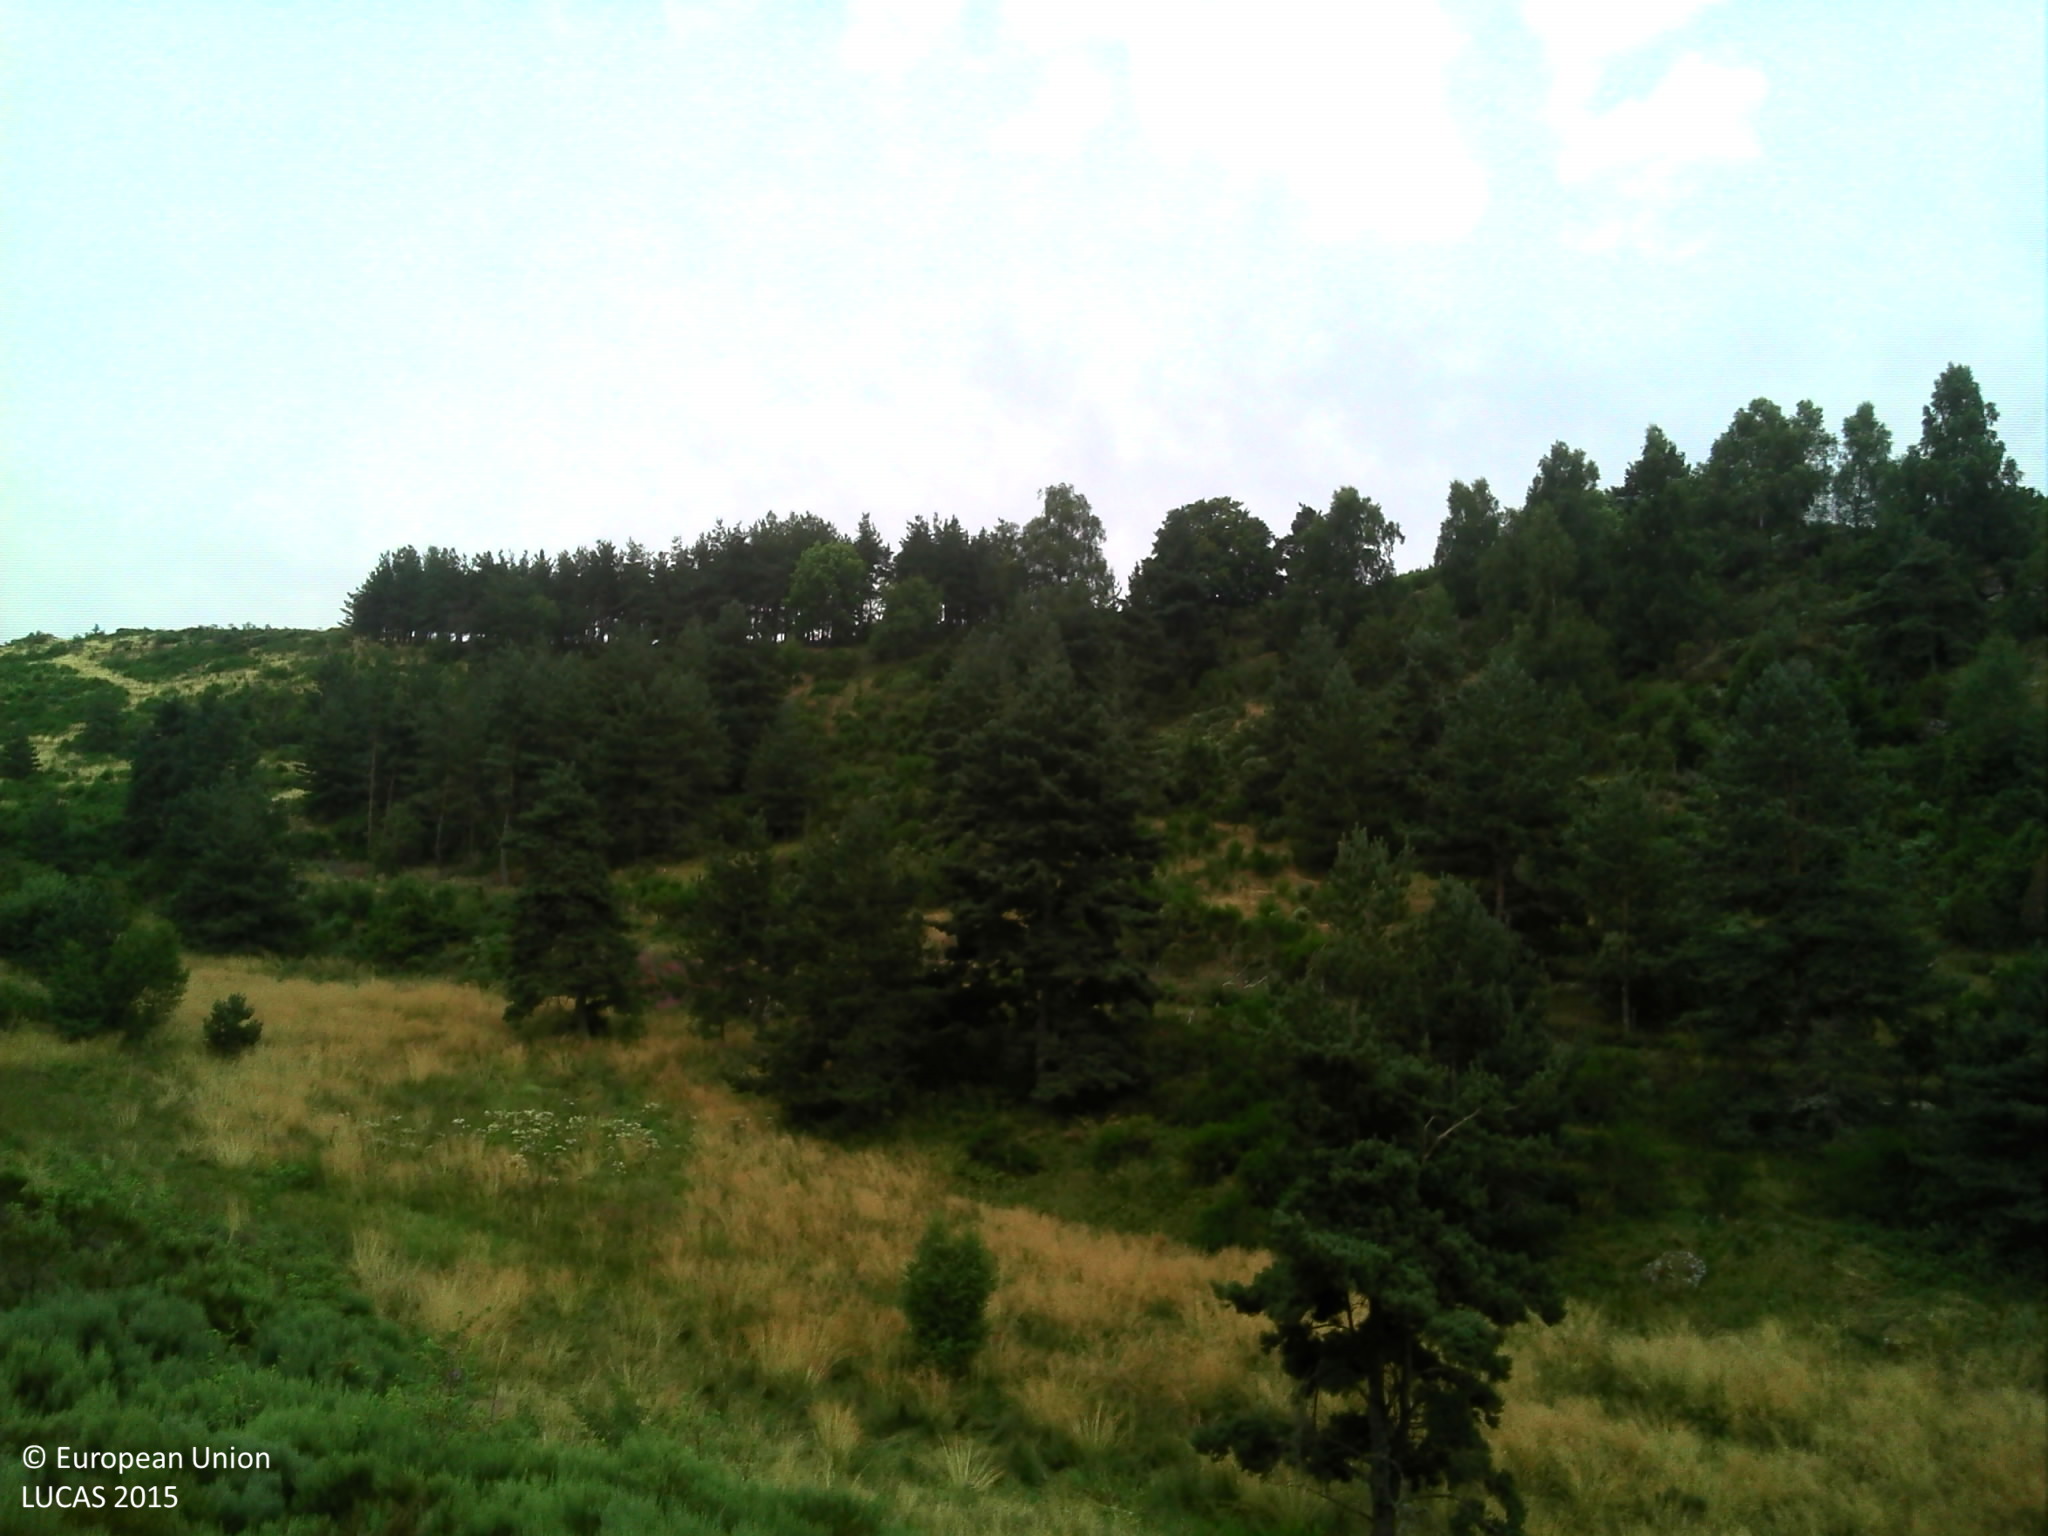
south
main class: Shrubland
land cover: Shrubland without tree cover
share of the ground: > 75 %
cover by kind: shrubs 100 %
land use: Agriculture (excluding fallow land and kitchen gardens)
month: July
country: FR
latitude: 44.6507
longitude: 3.4603
